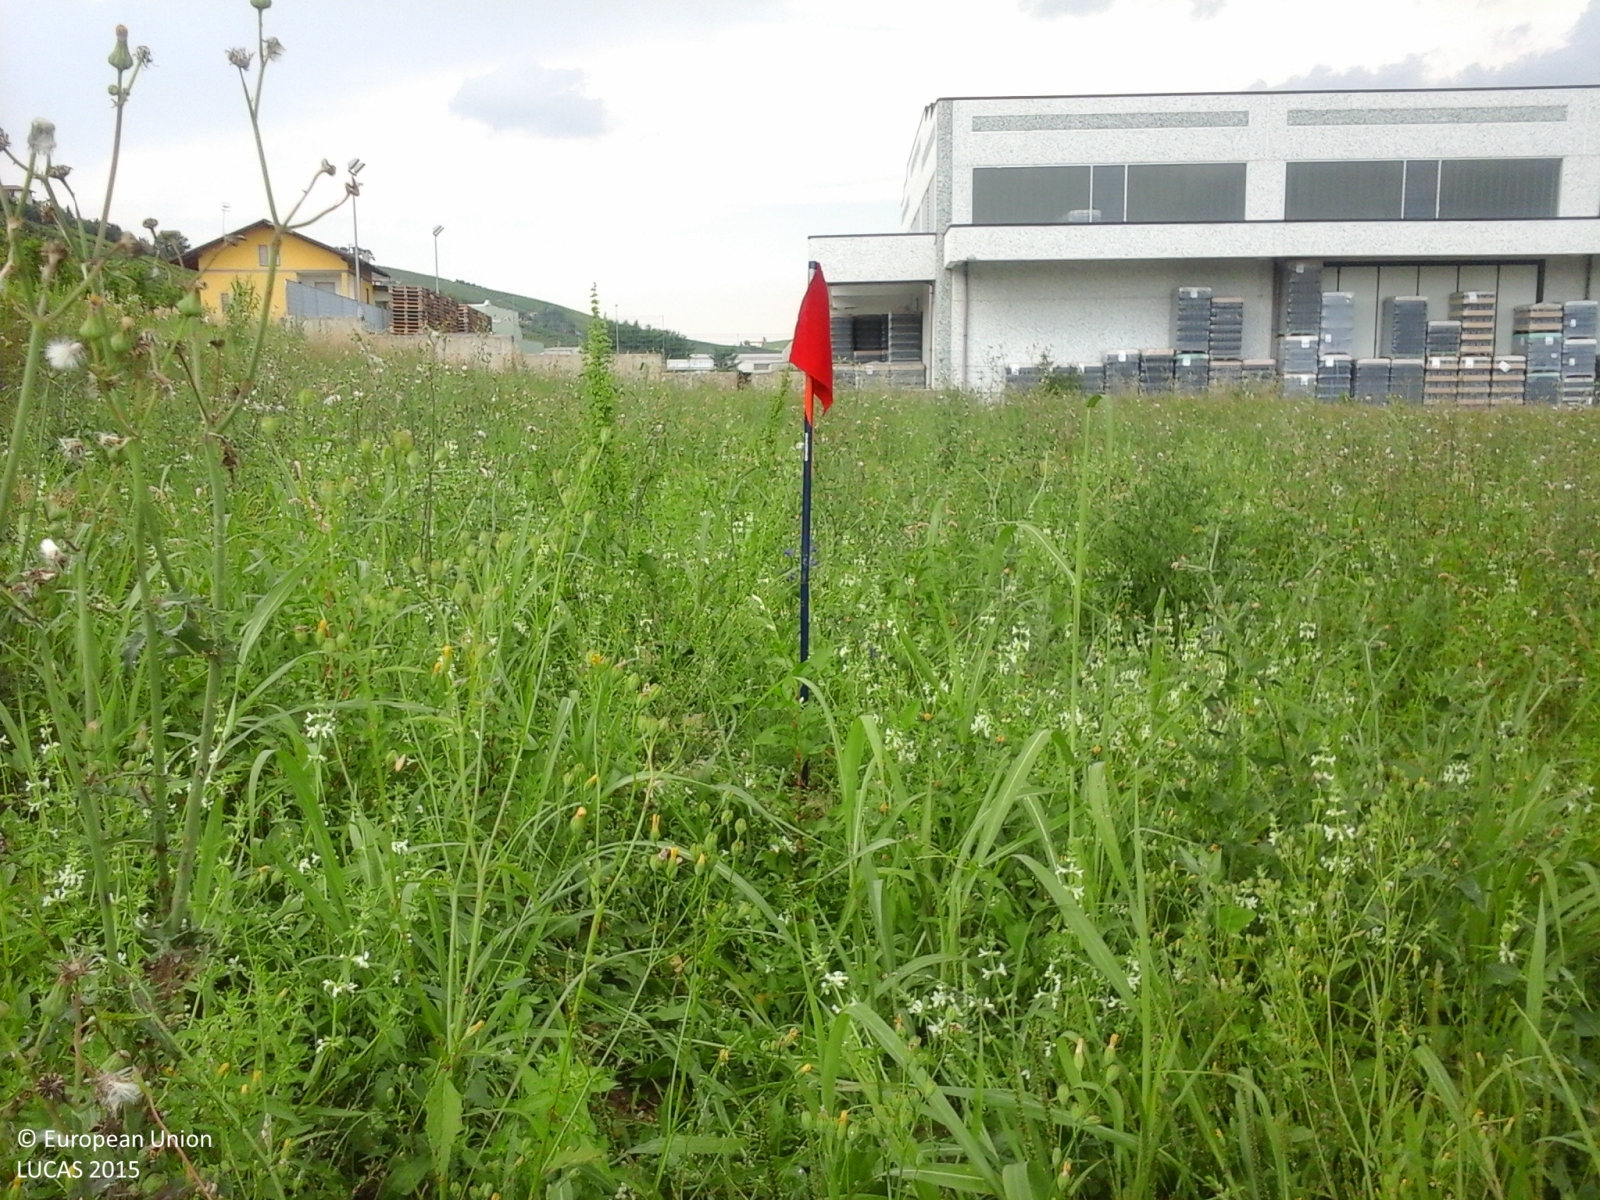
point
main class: Grassland
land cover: Spontaneously vegetated surfaces
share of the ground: > 75 %
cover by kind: herbaceous plants 90 %, consolidated bare surface 10 %
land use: Fallow land
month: June
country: IT
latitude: 44.7304
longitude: 8.1224
